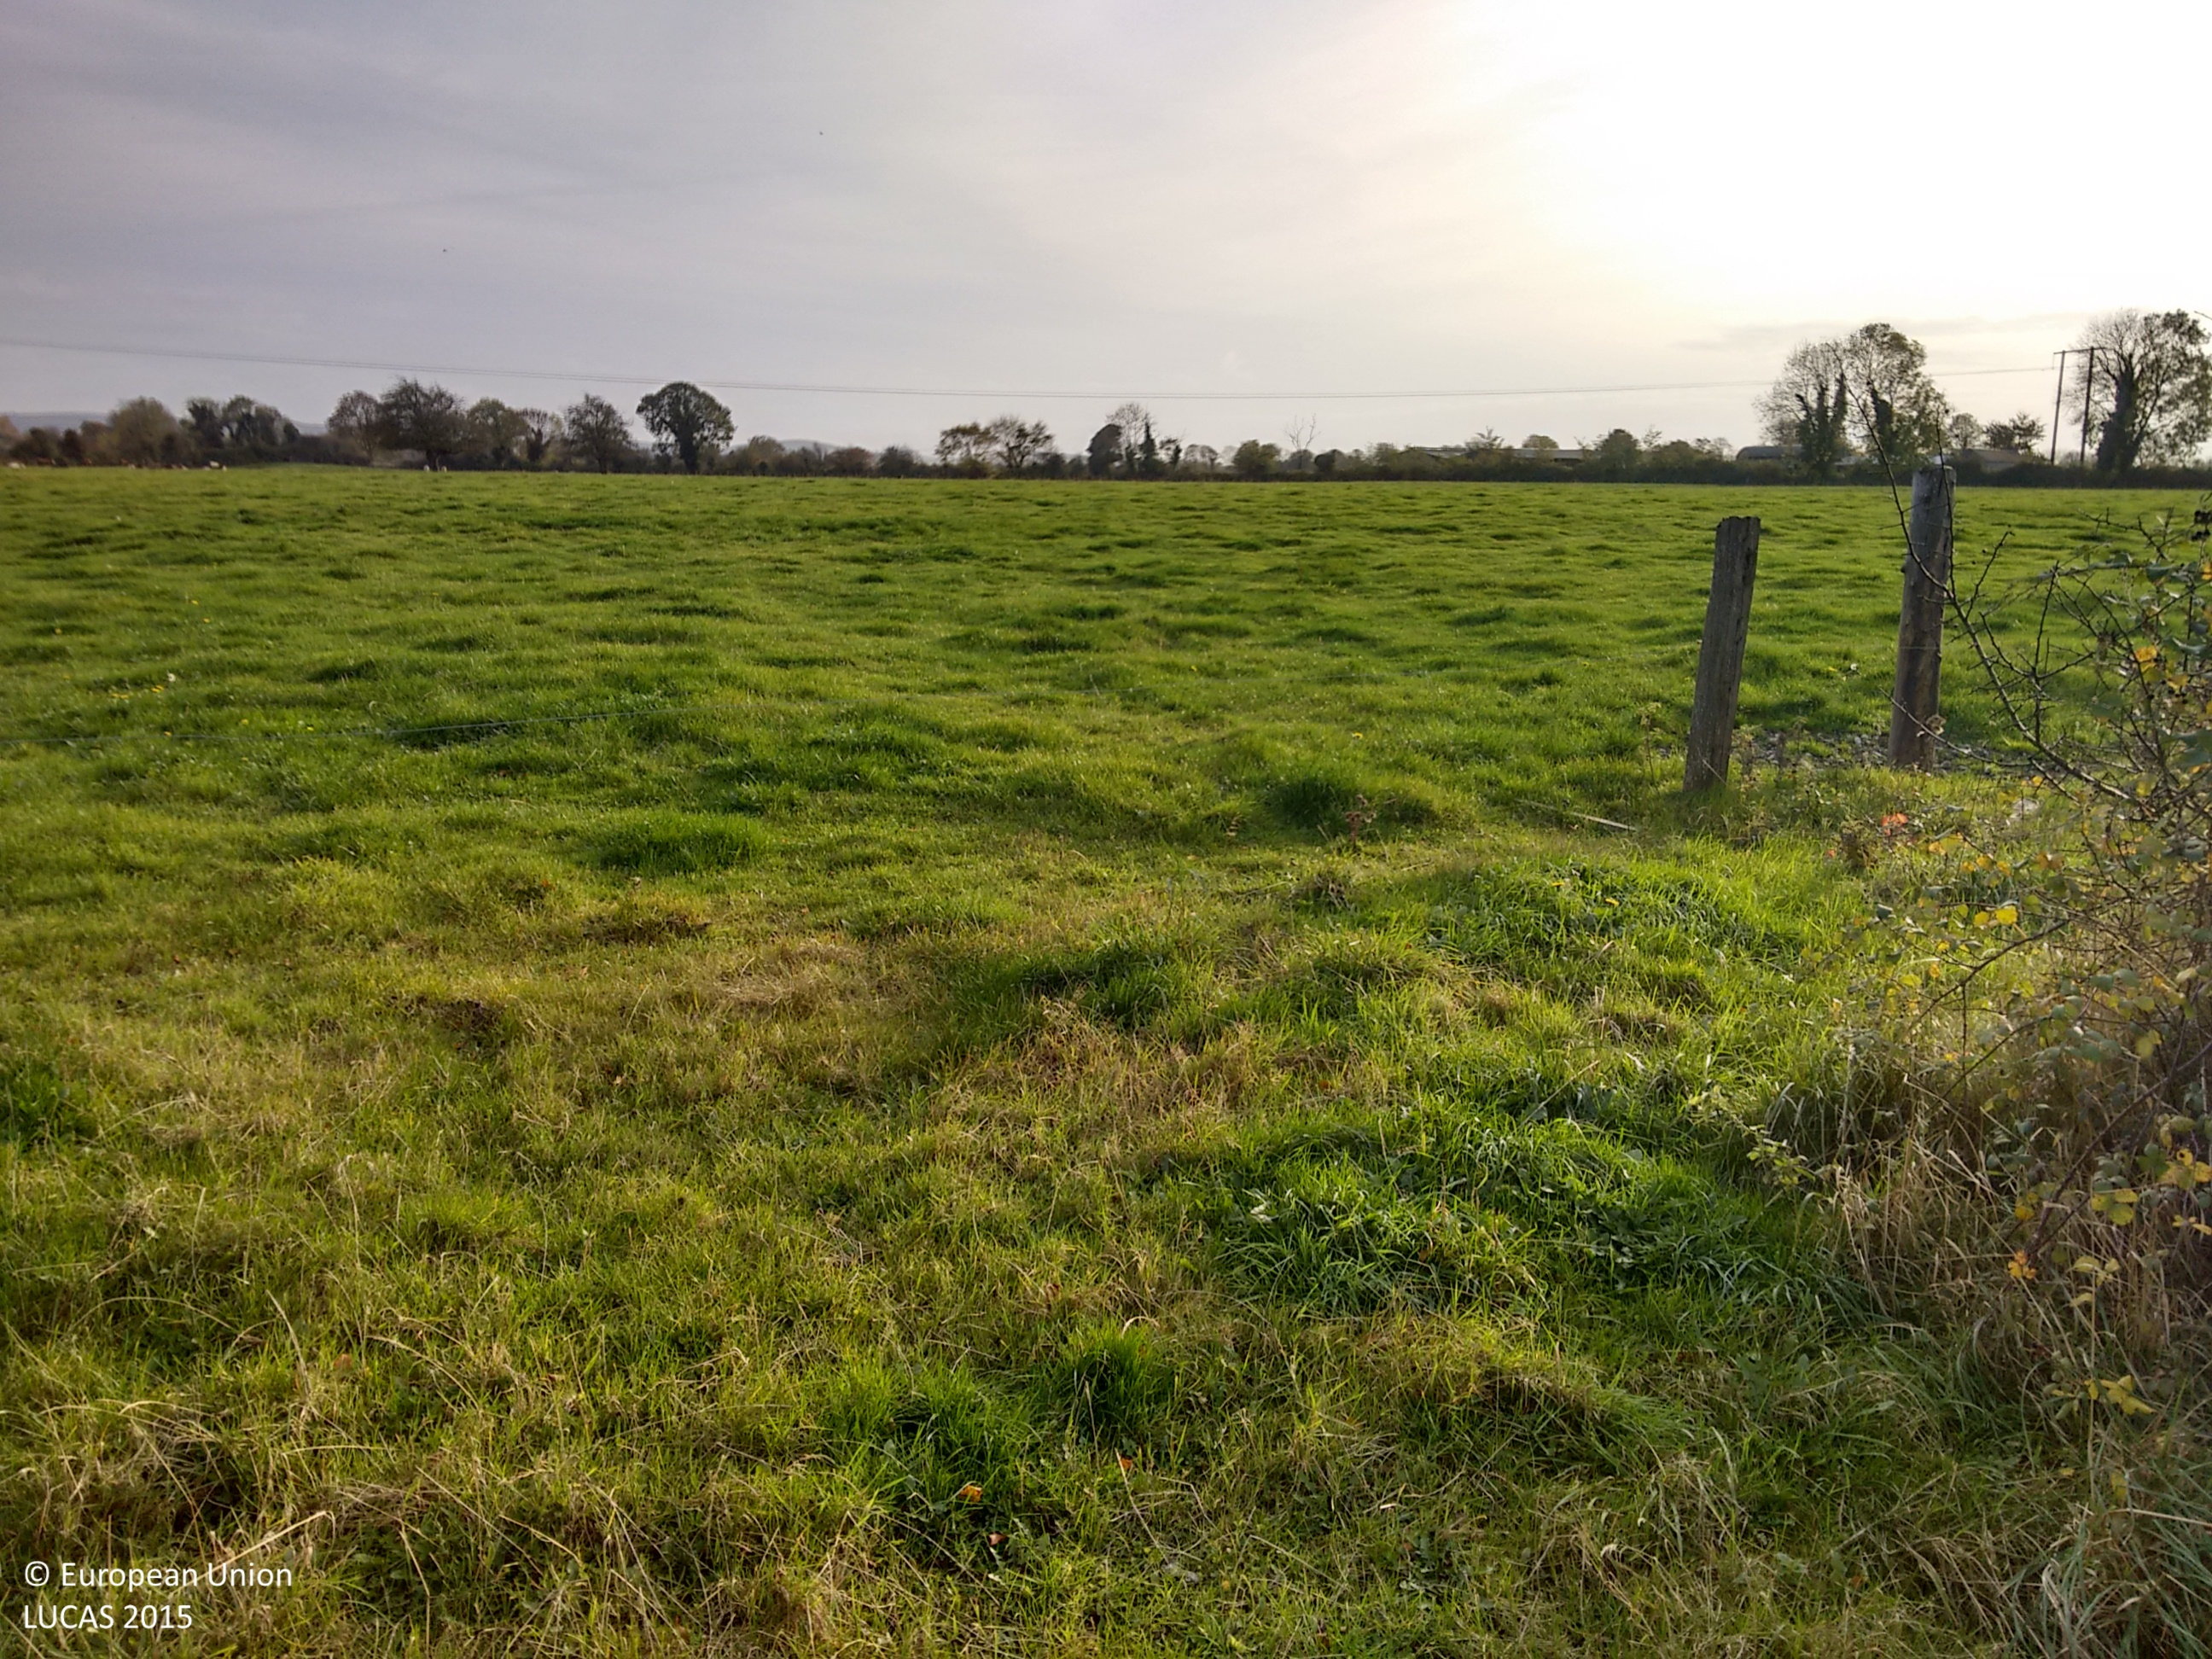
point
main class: Grassland
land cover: Grassland without tree/shrub cover
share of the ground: > 75 %
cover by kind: herbaceous plants 100 %
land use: Agriculture (excluding fallow land and kitchen gardens)
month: October
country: IE
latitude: 53.1684
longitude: -7.7124
